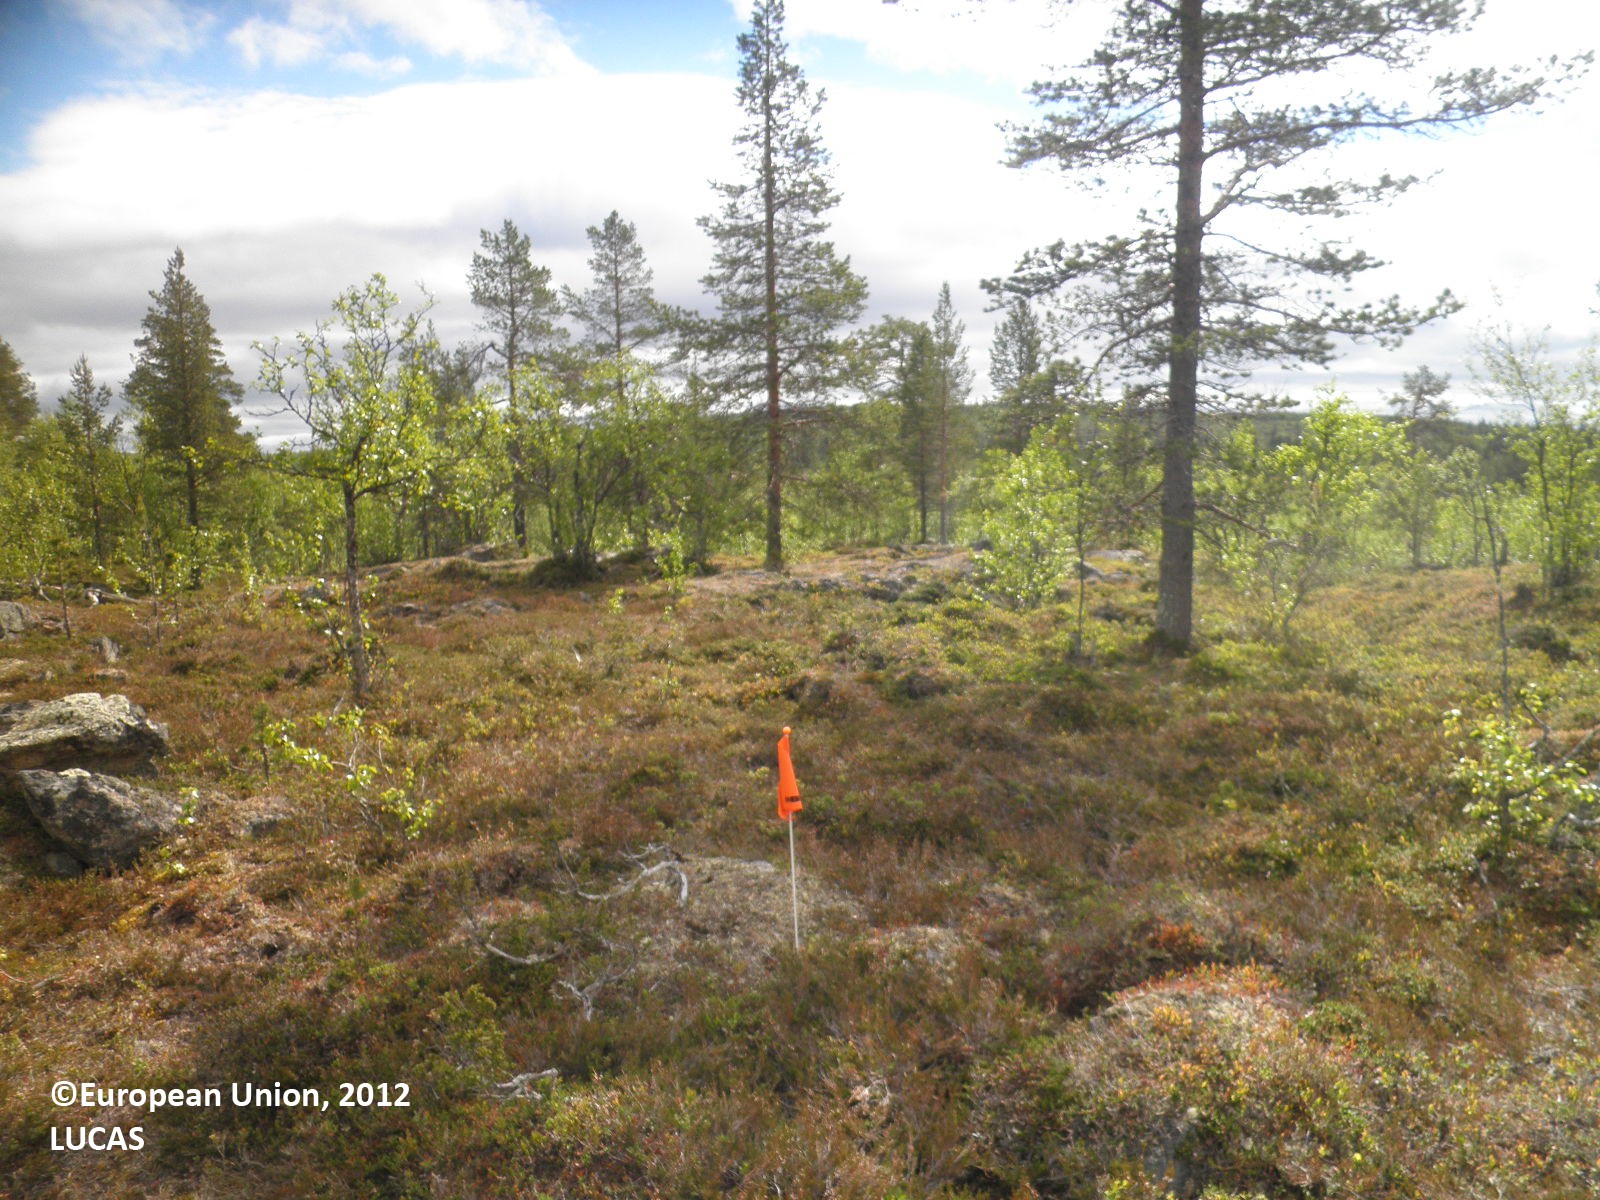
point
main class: Woodland
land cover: Pine dominated mixed woodland
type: boreal forest
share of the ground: 10 - 25 %
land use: Forestry
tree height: > 5 m
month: July
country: FI
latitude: 68.5733
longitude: 26.2113
